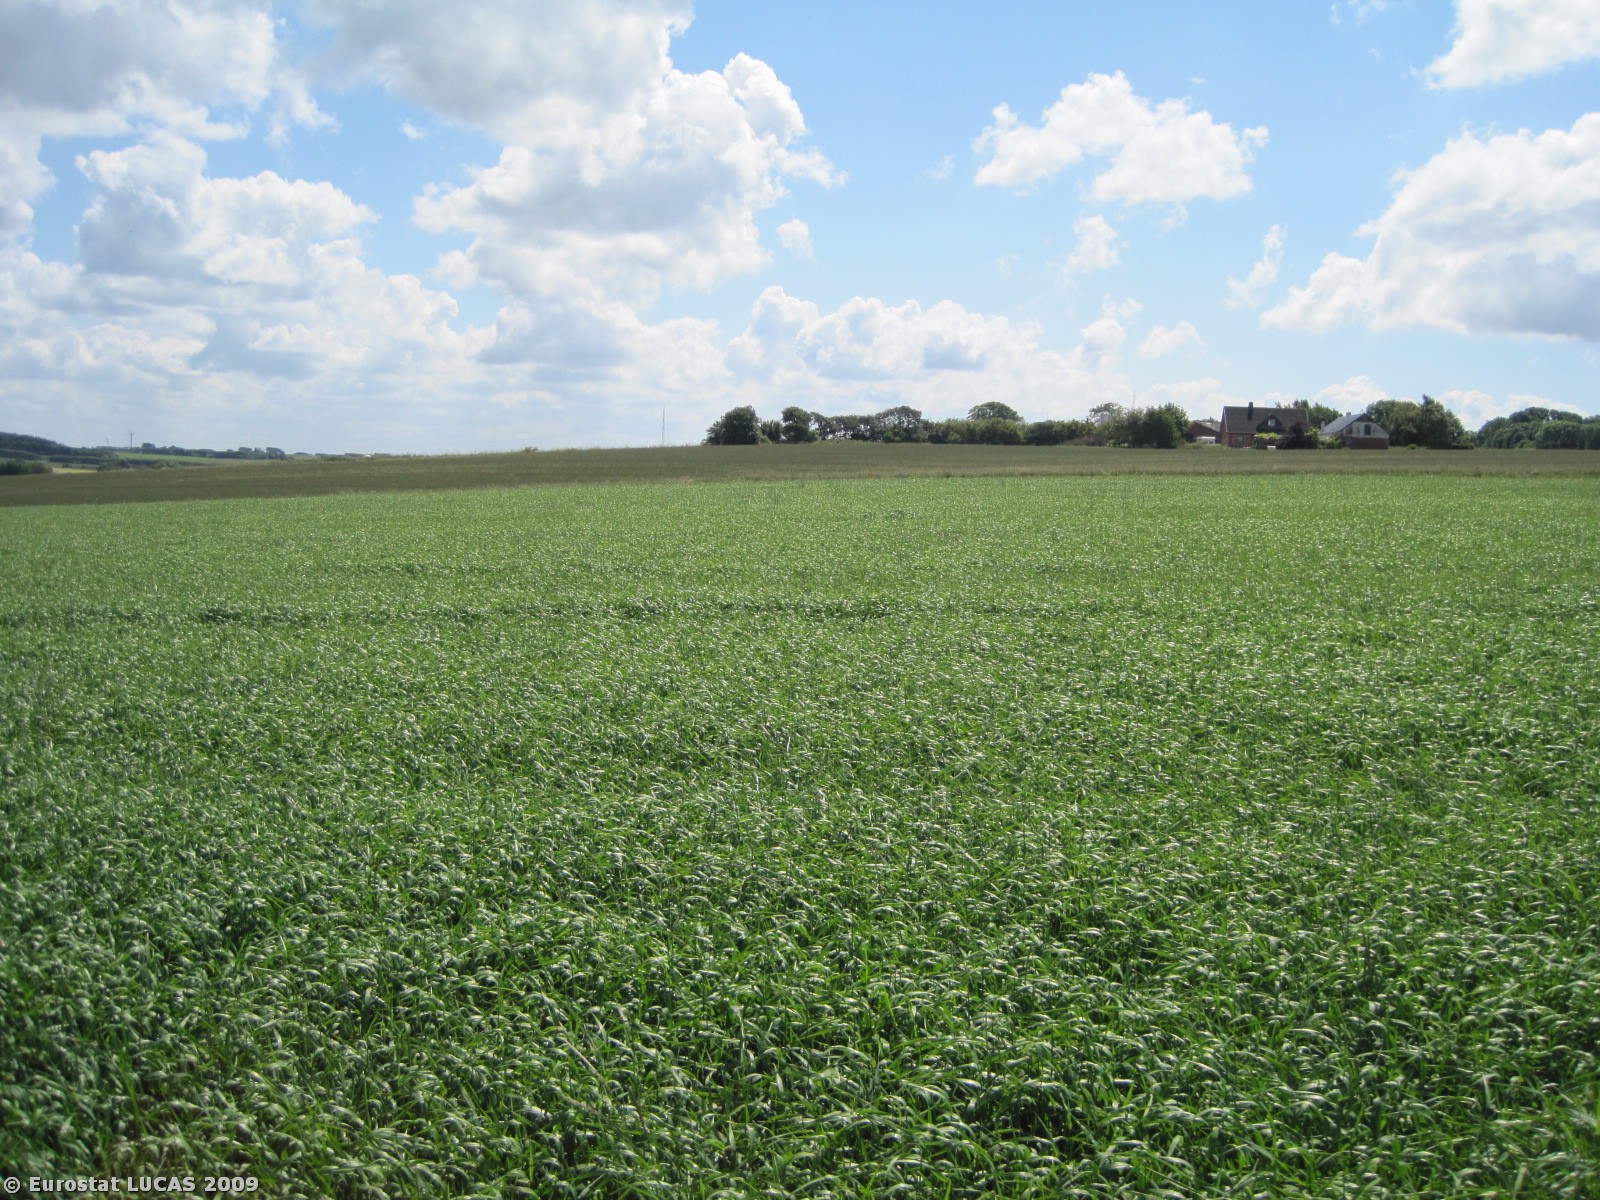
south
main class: Cropland
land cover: Barley
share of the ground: > 75 %
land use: Agriculture (excluding fallow land and kitchen gardens)
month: June
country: DK
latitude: 56.6682
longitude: 8.8756
